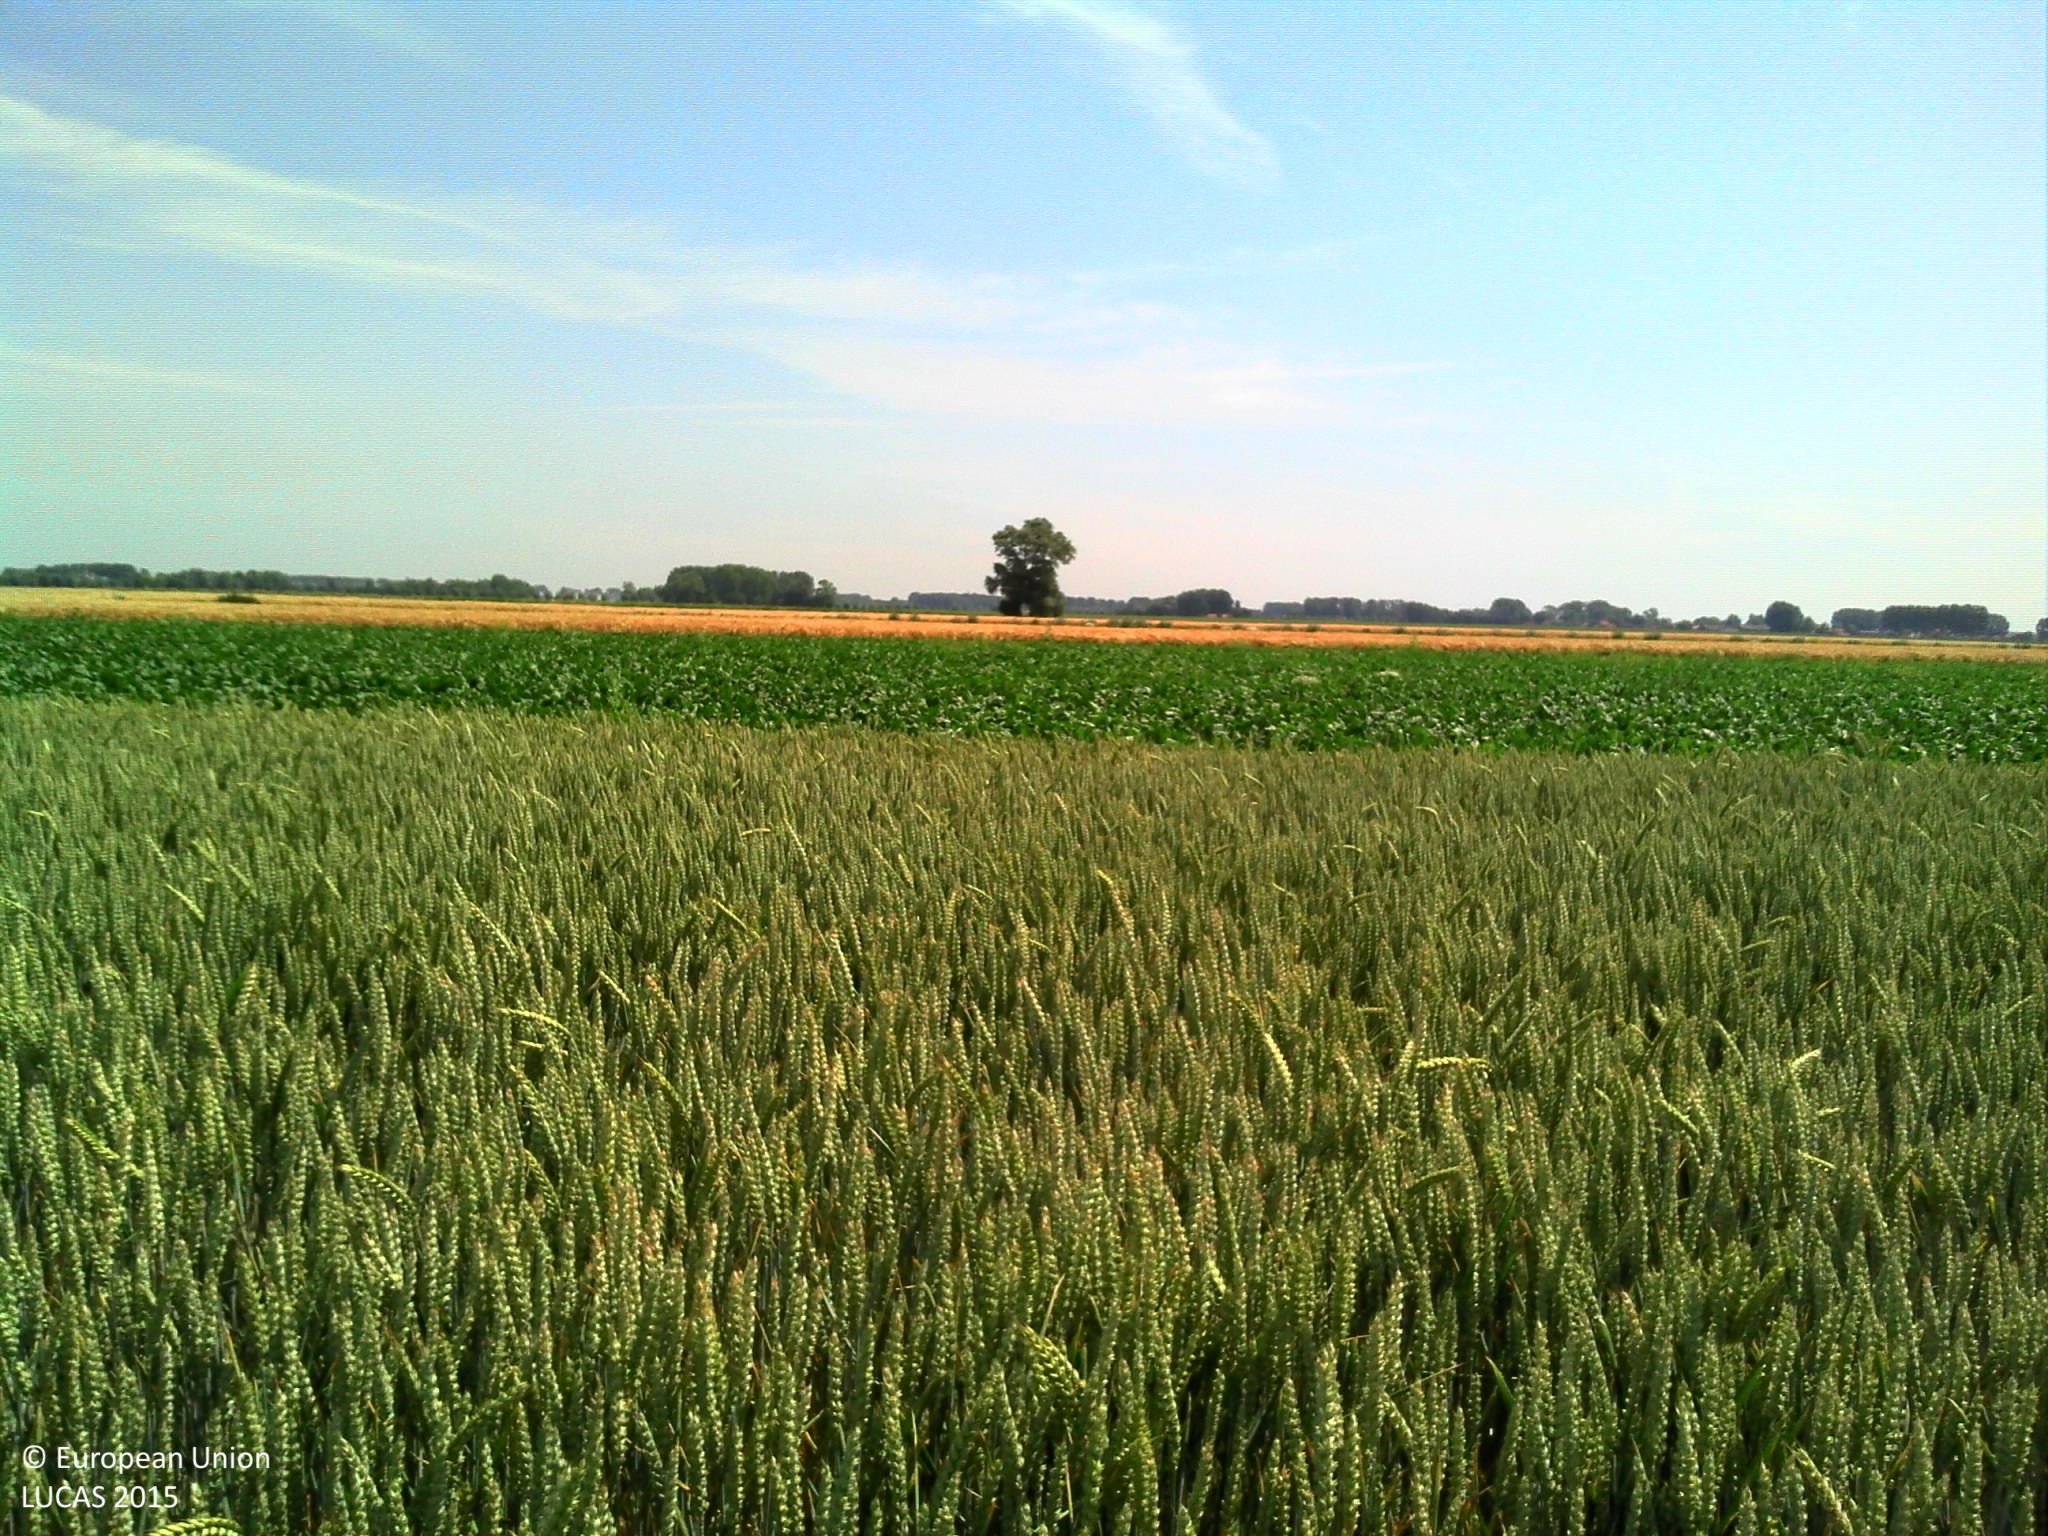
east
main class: Cropland
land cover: Common wheat
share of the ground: > 75 %
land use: Agriculture (excluding fallow land and kitchen gardens)
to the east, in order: Common wheat; Sugar beet; Barley; Spontaneously vegetated surfaces; Barley
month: July
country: BE
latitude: 51.2729
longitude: 3.3836
